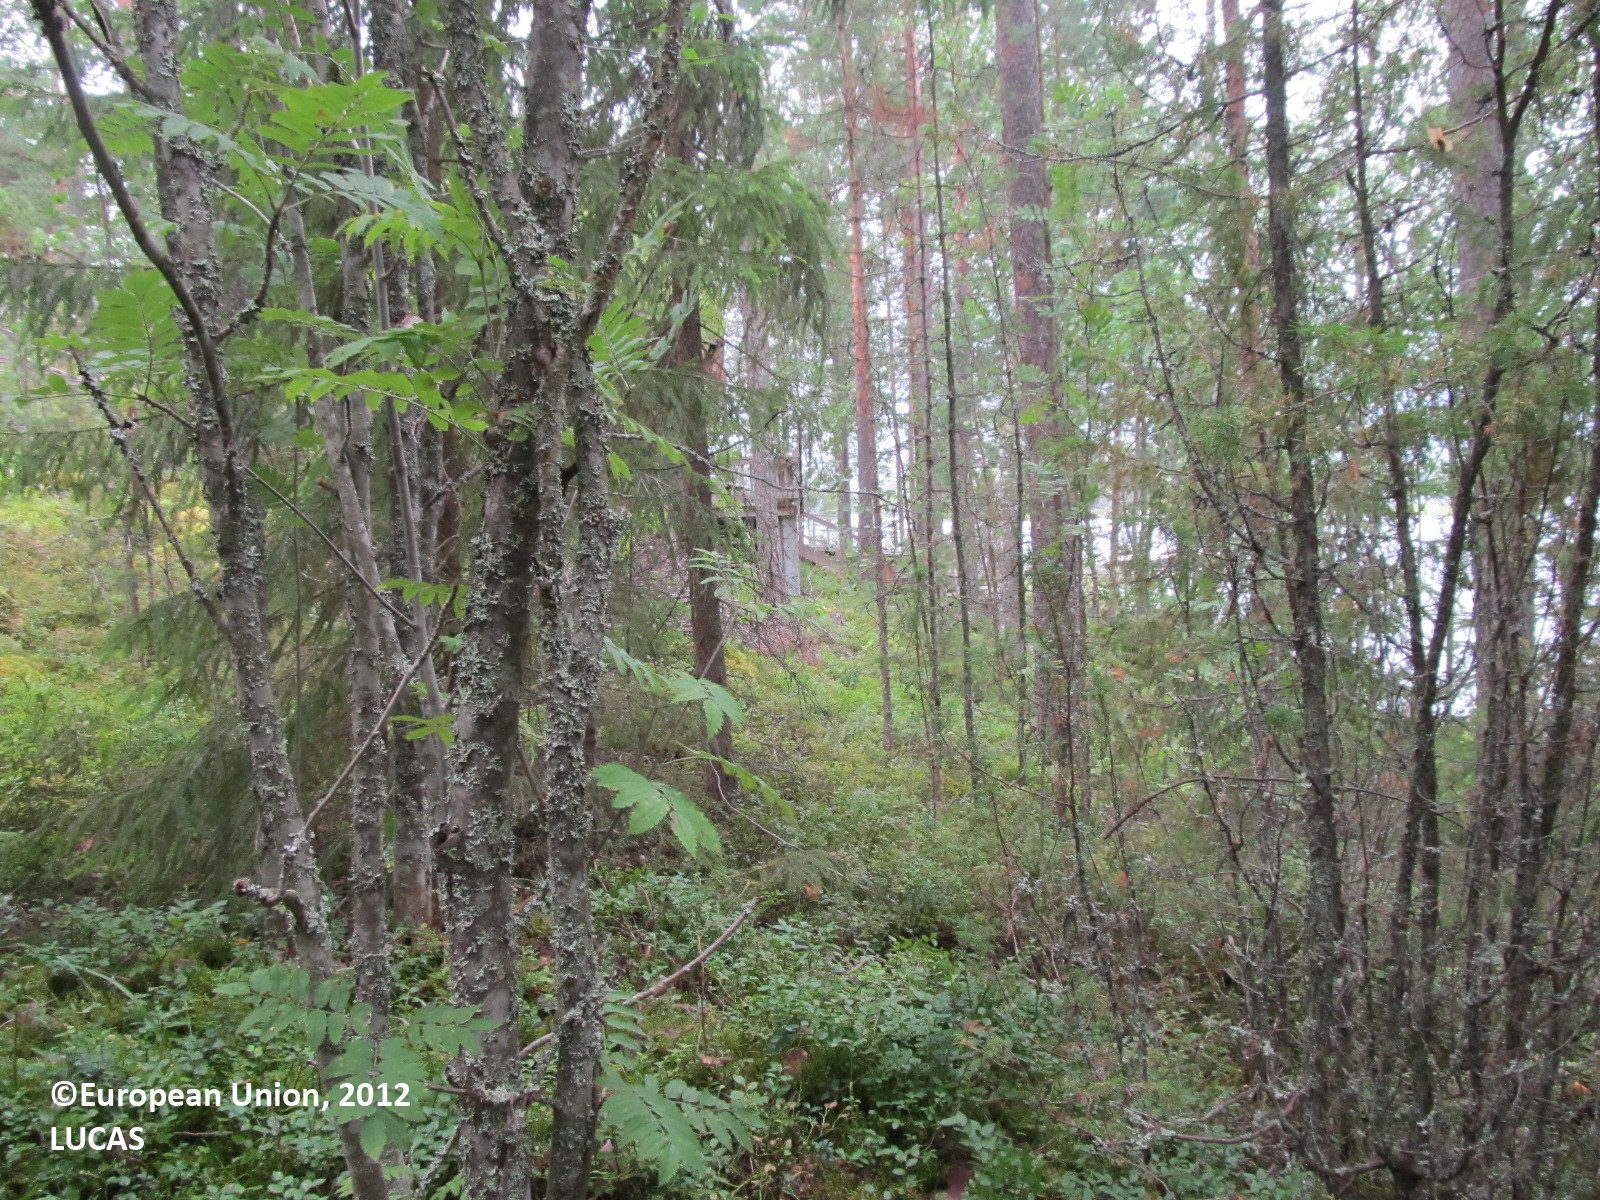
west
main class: Woodland
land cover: Spruce dominated mixed woodland
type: boreal forest
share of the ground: 25 - 50 %
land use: Forestry
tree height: > 5 m
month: August
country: FI
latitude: 62.1780
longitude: 28.0306
